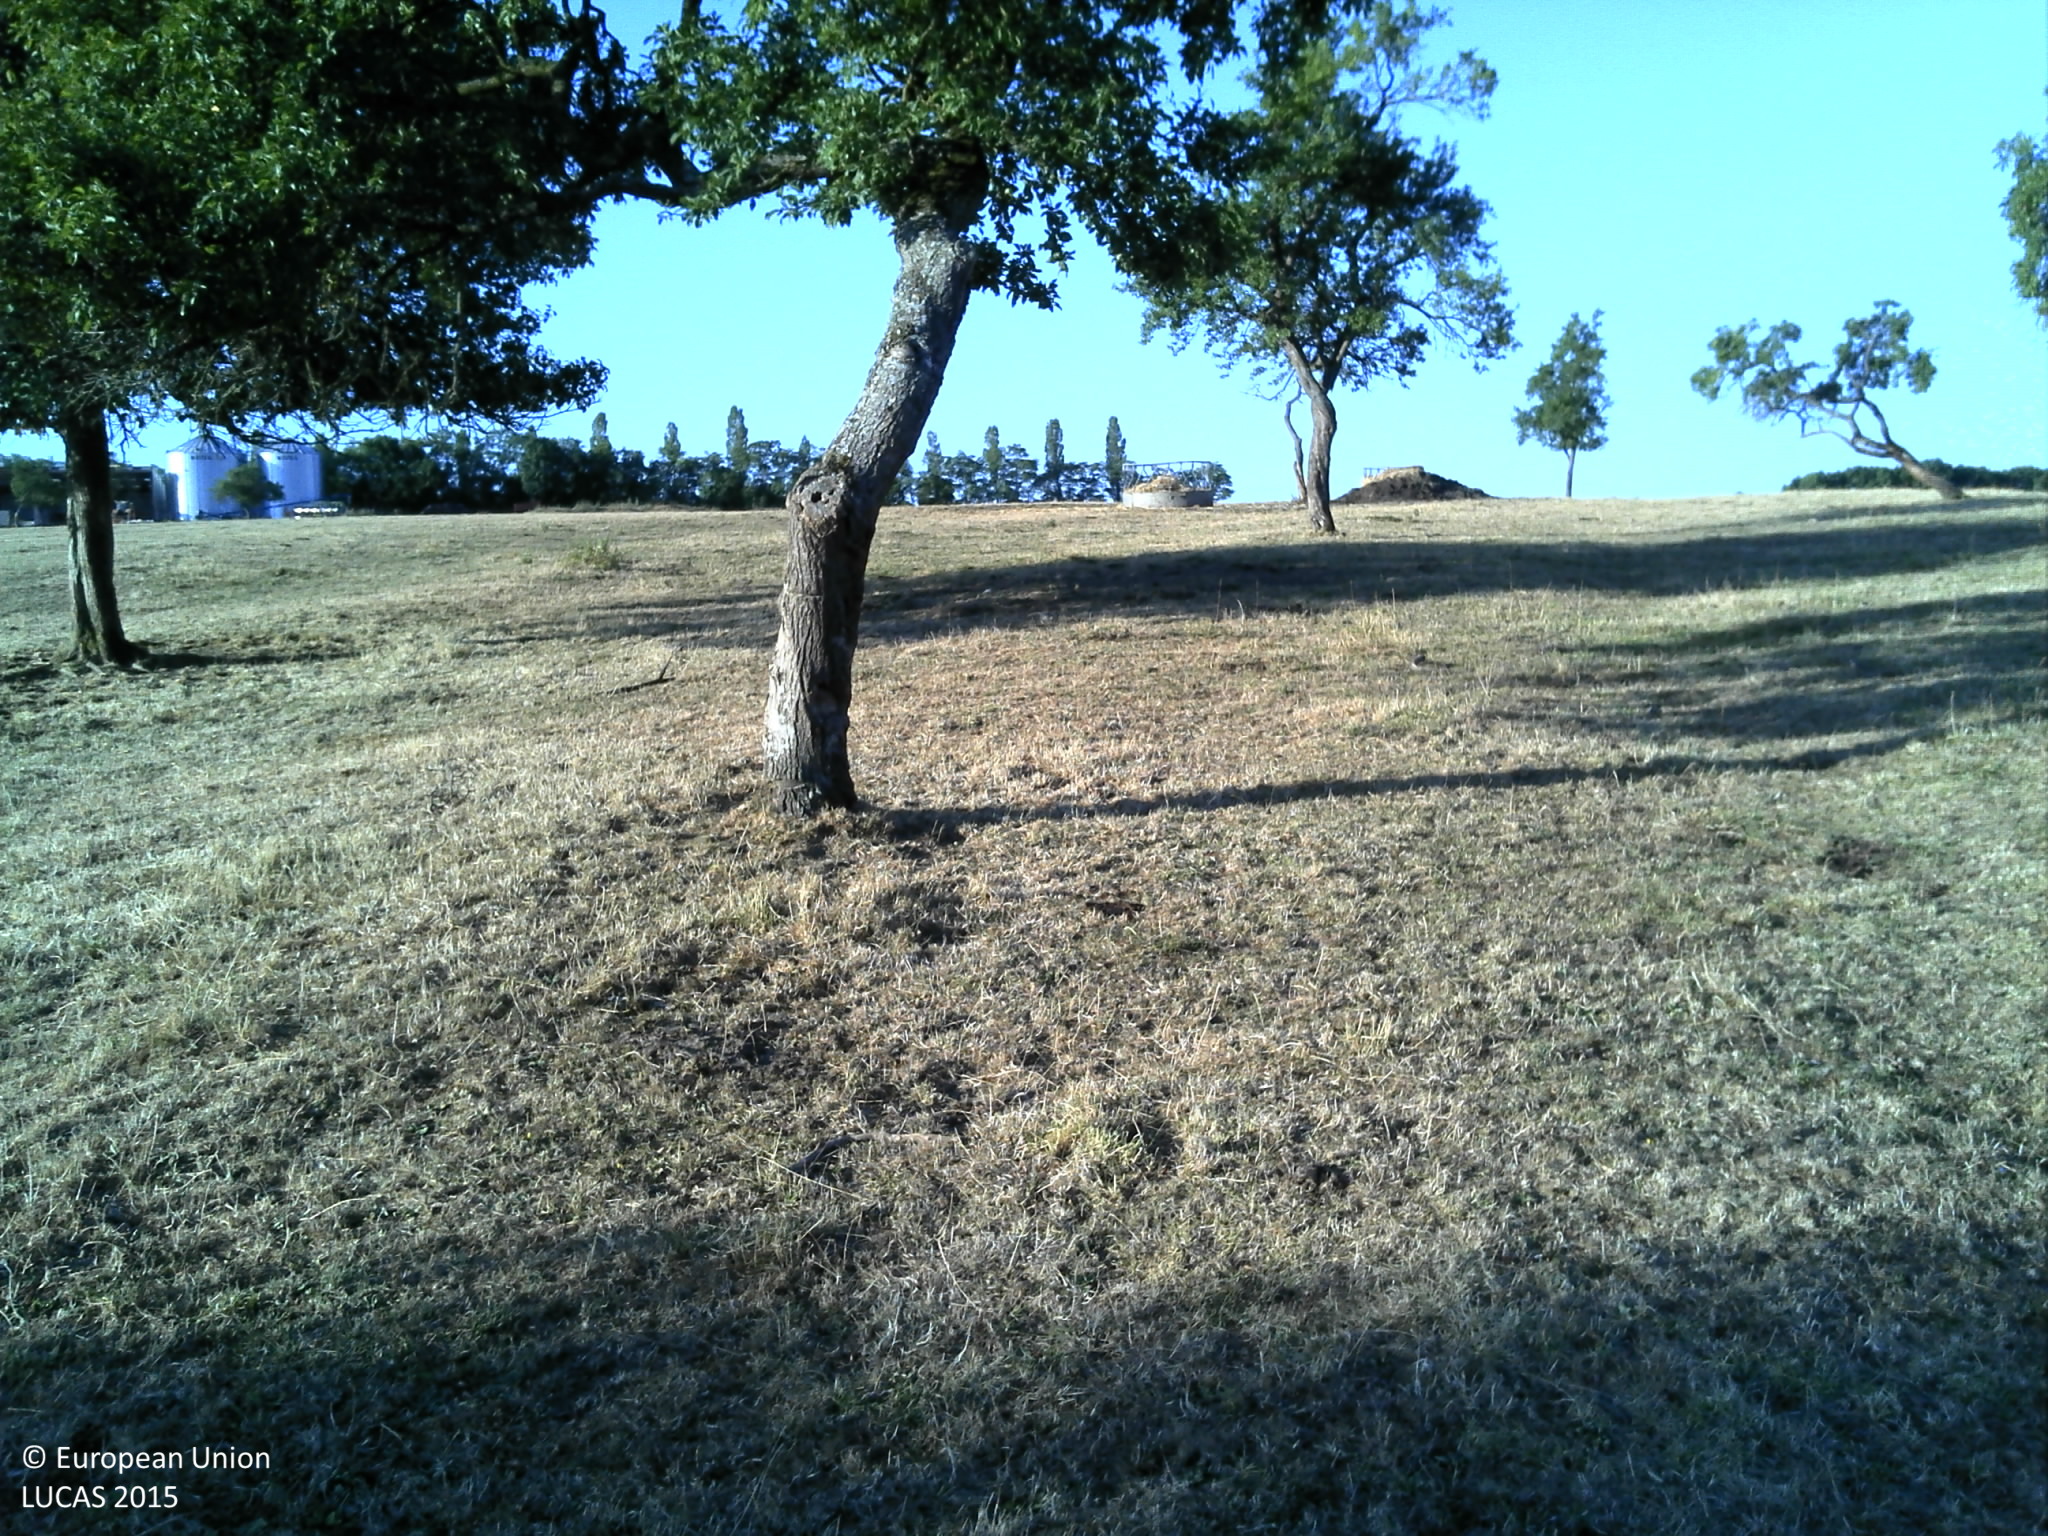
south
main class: Grassland
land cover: Grassland with sparse tree/shrub cover
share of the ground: > 75 %
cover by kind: herbaceous plants 95 %, broadleaved forest trees 5 %
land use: Agriculture (excluding fallow land and kitchen gardens)
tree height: > 5 m
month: July
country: FR
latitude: 48.3139
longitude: 6.0223
